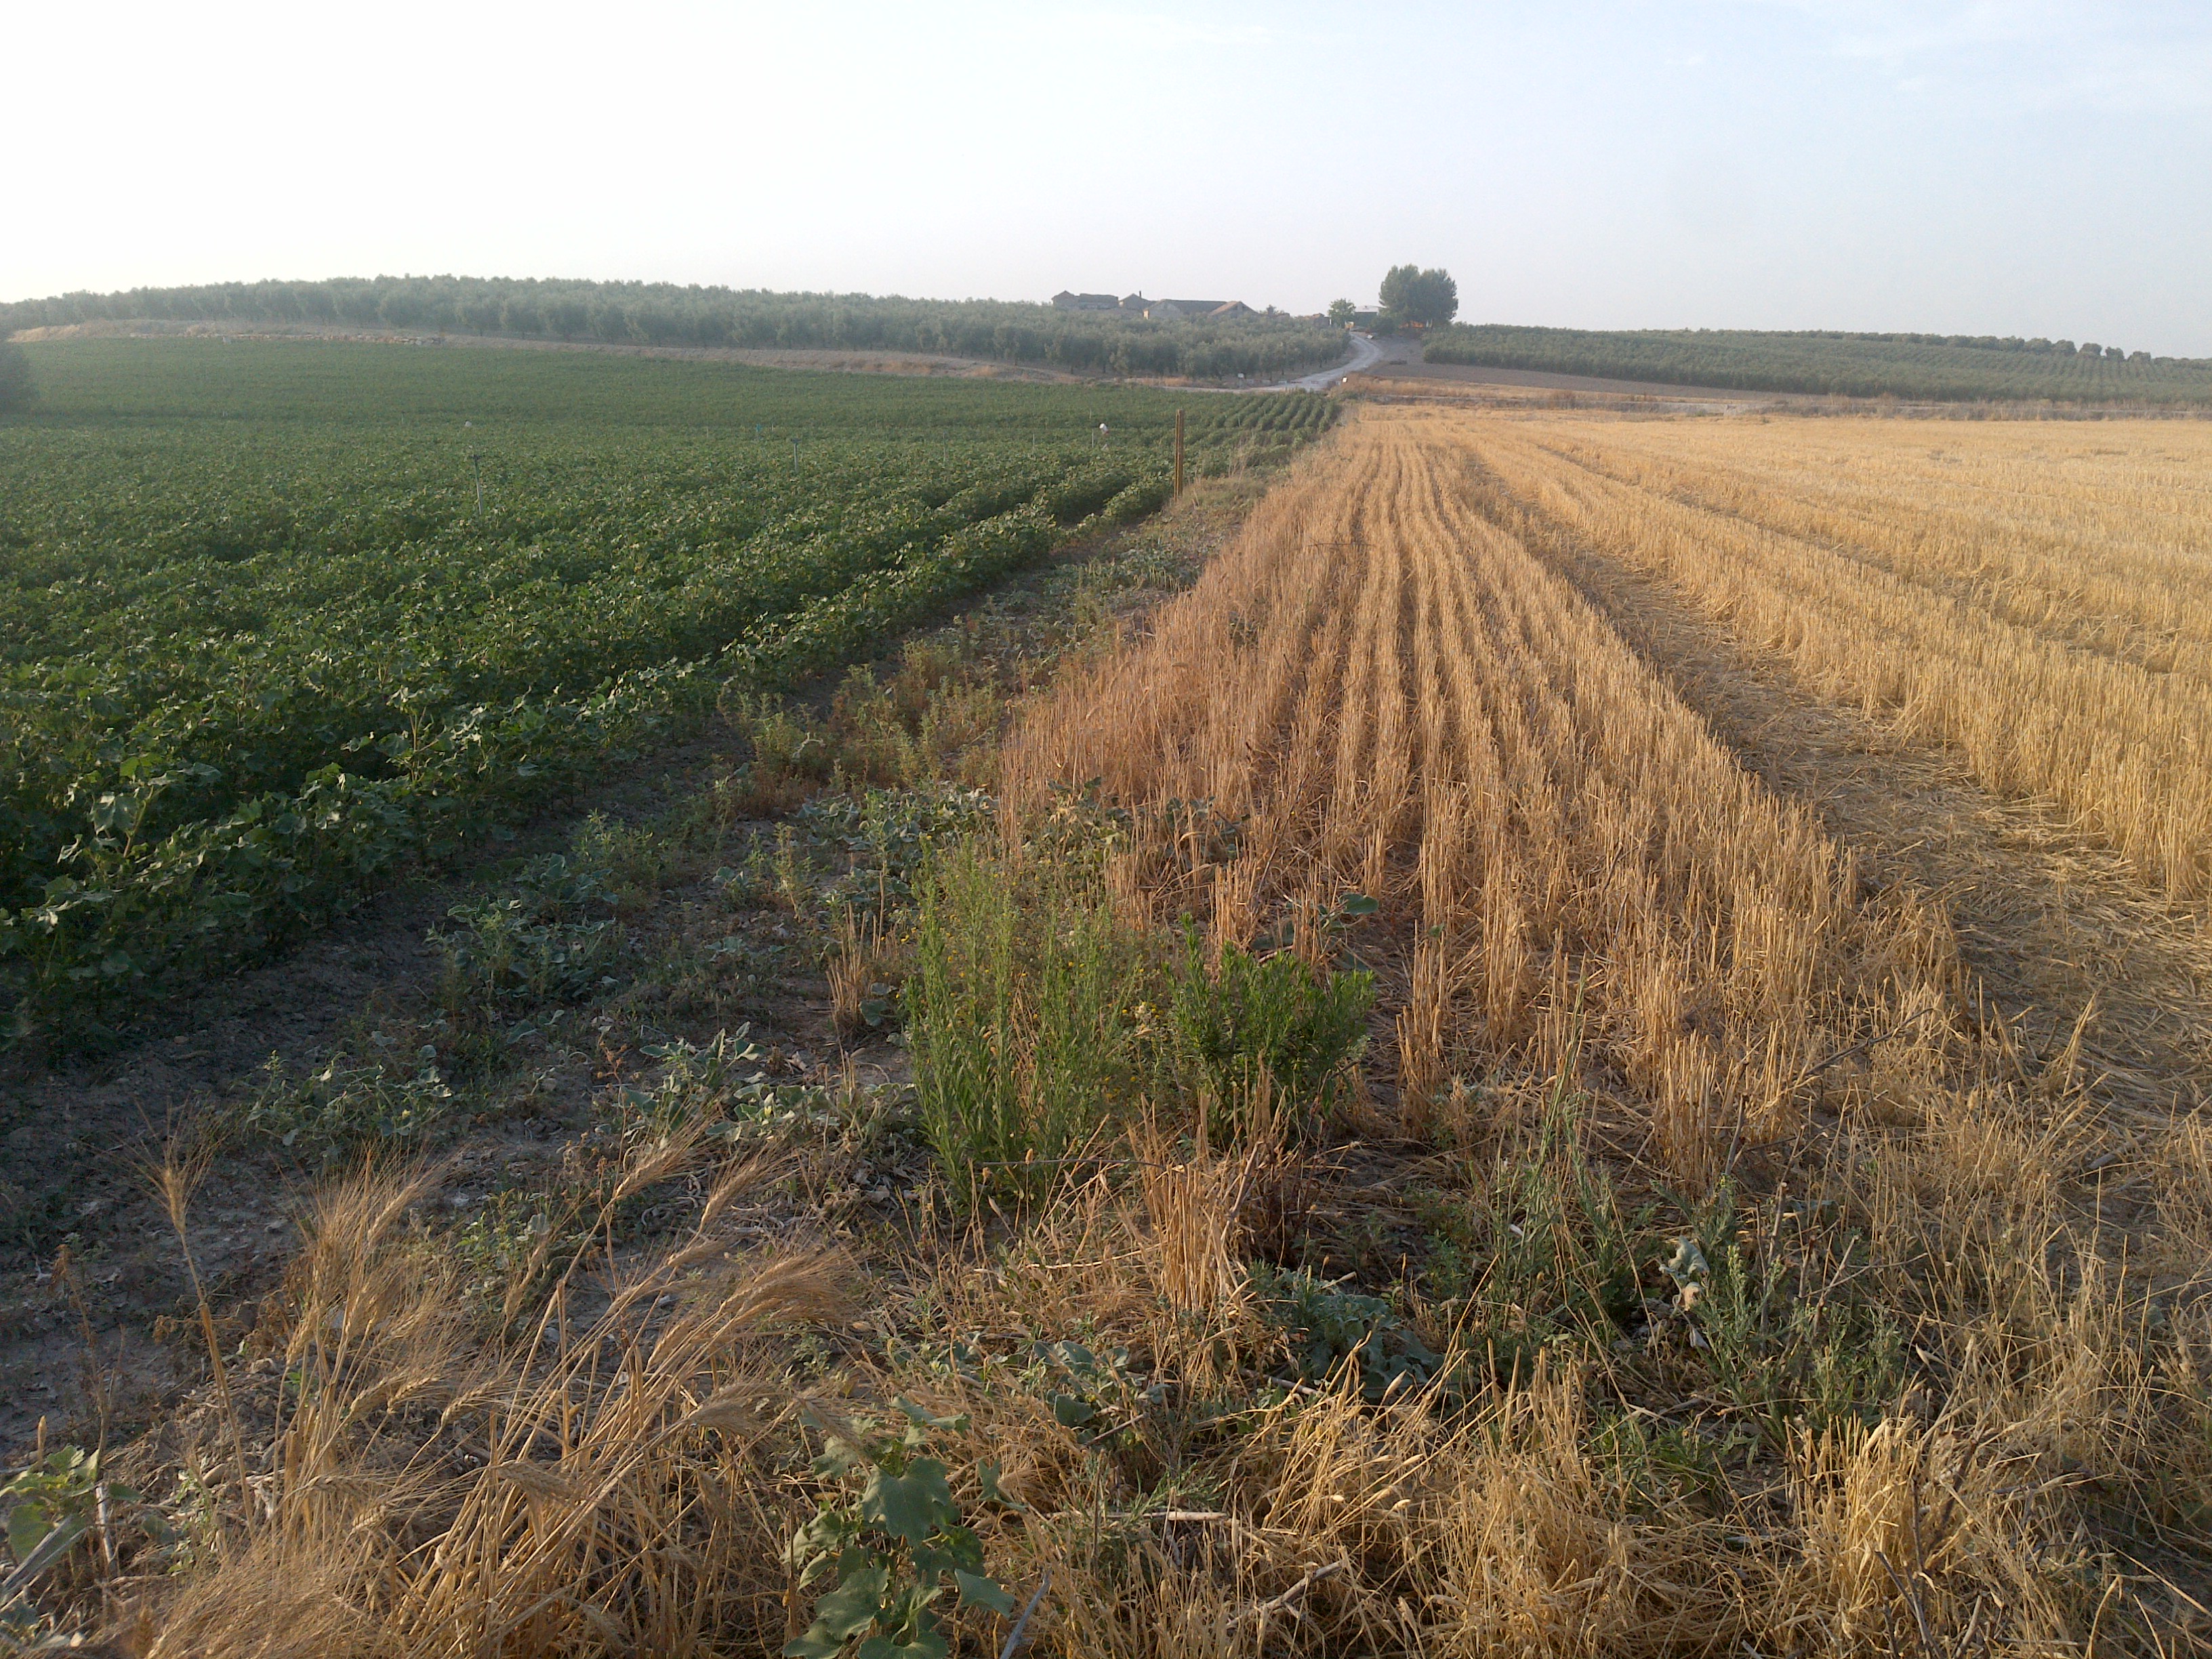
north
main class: Cropland
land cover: Durum wheat
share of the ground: < 10 %
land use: Agriculture (excluding fallow land and kitchen gardens)
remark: Harvested field
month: July
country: ES
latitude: 37.5108
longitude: -4.8633
